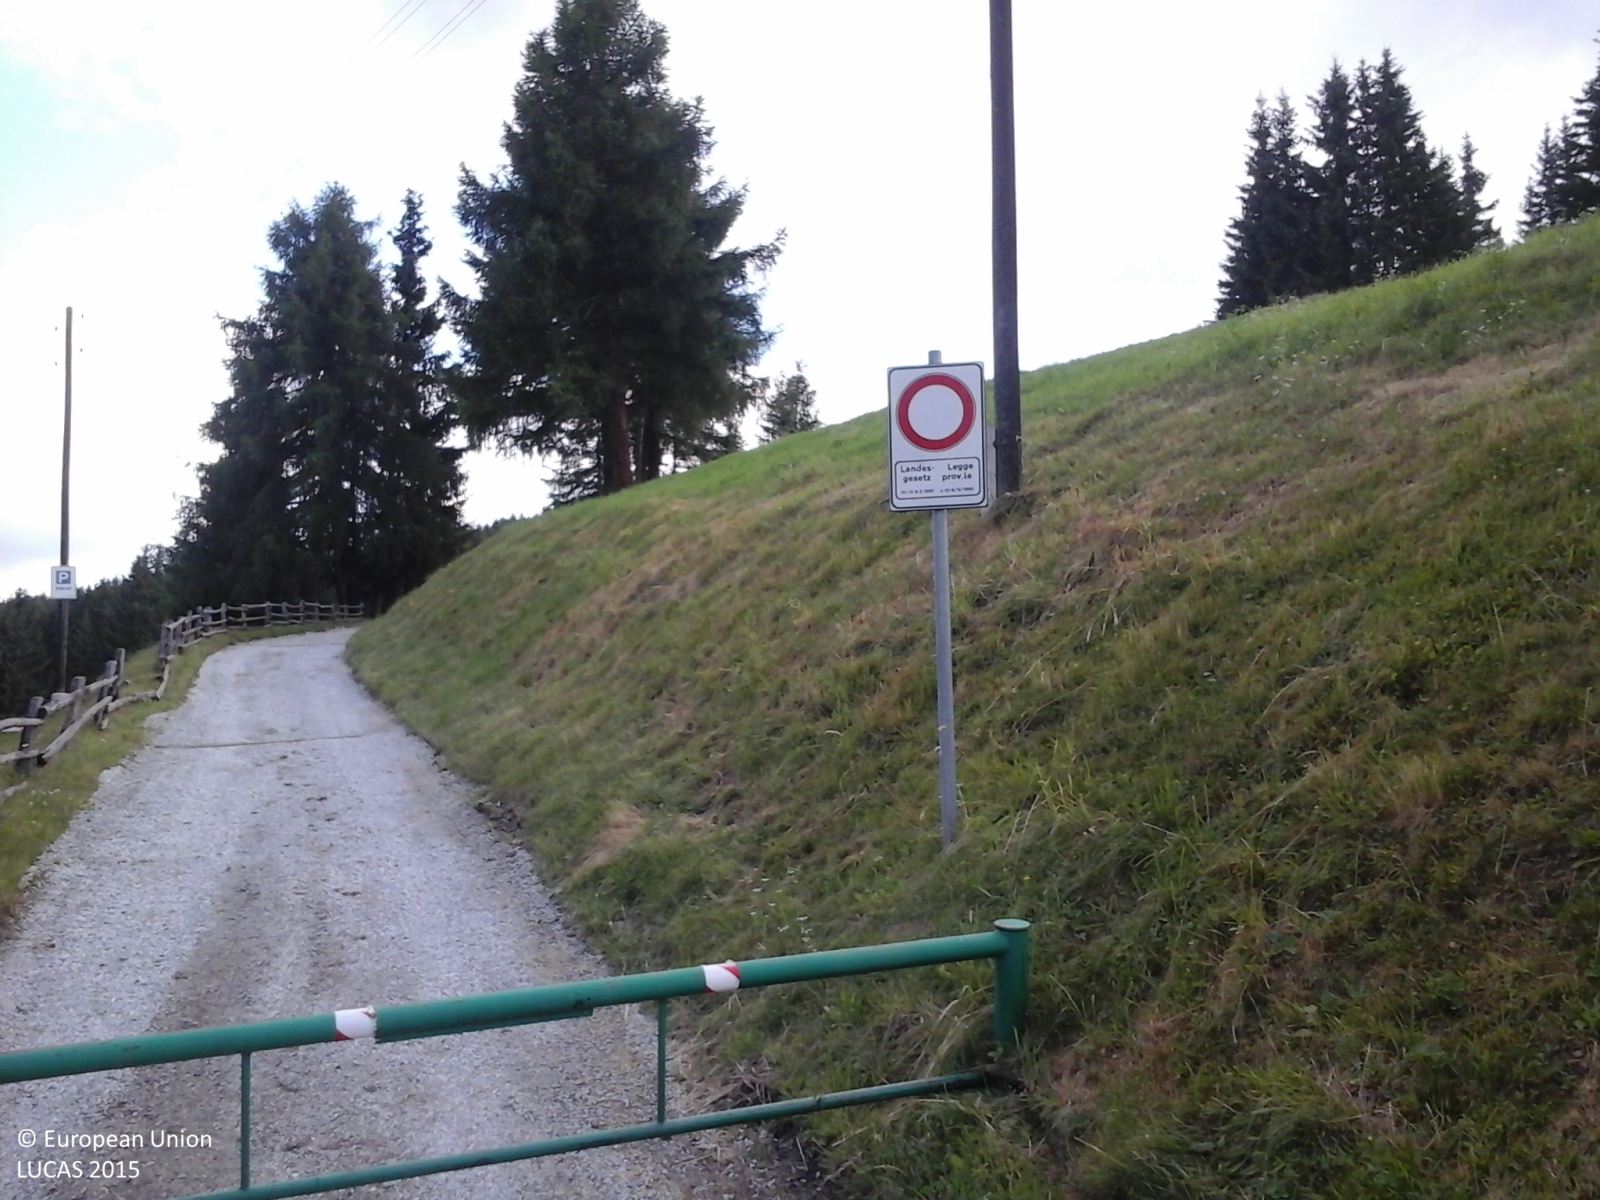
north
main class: Grassland
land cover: Grassland without tree/shrub cover
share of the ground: > 75 %
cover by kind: herbaceous plants 100 %
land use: Agriculture (excluding fallow land and kitchen gardens)
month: July
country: IT
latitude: 46.7690
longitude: 11.7659
